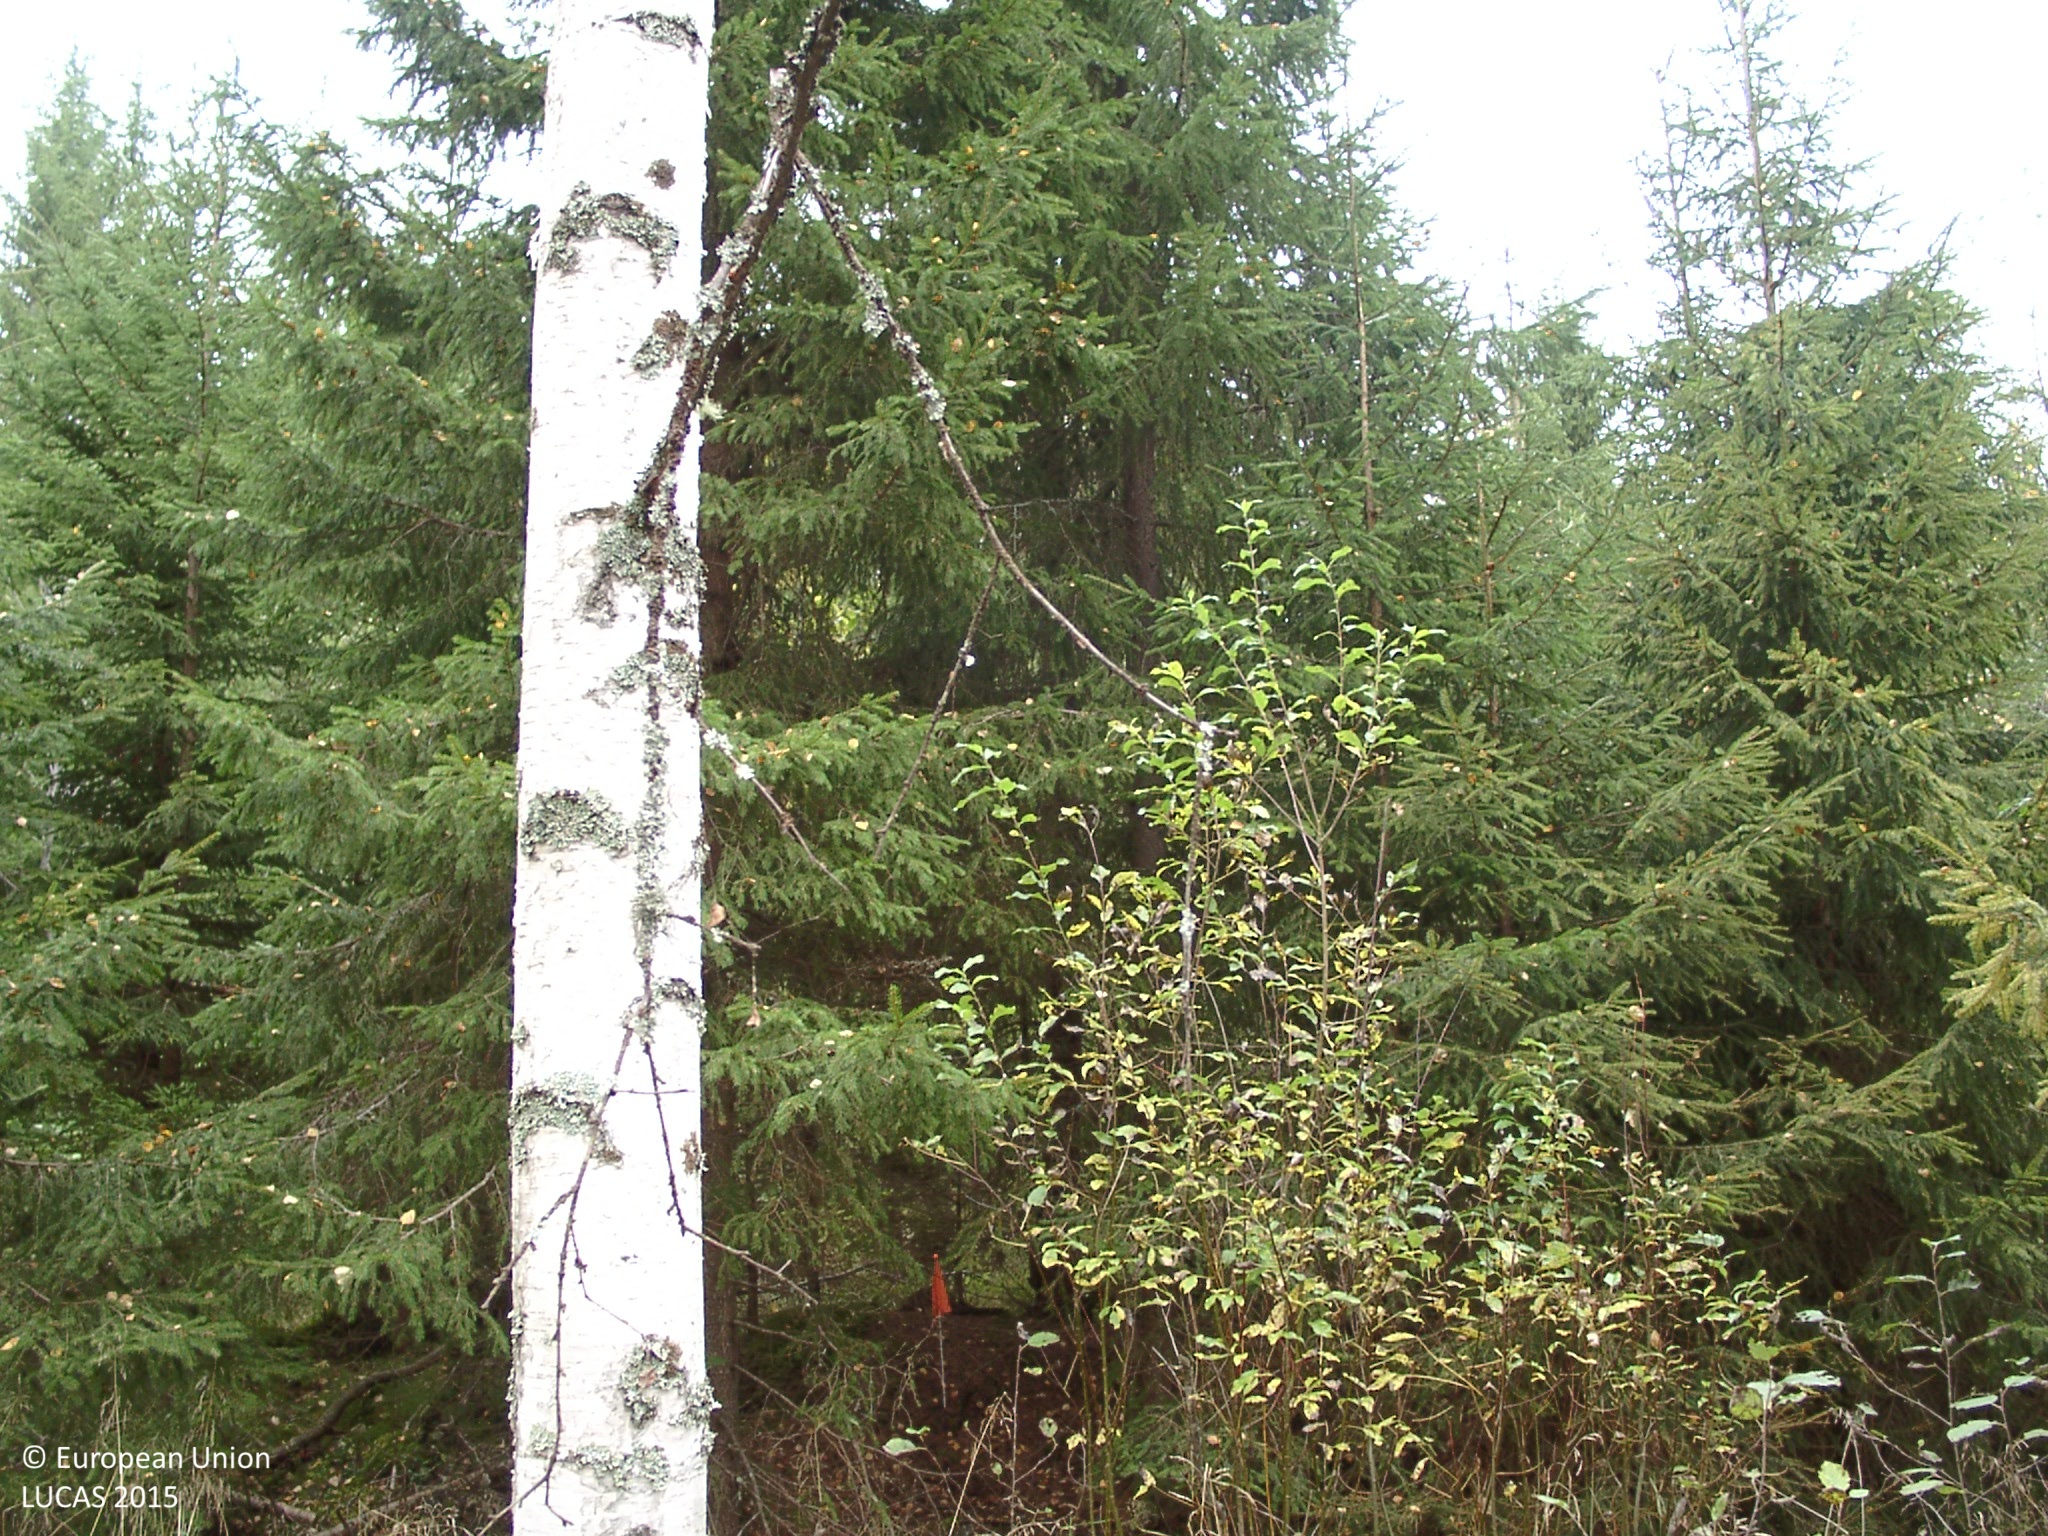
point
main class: Woodland
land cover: Spruce dominated coniferous woodland
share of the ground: > 75 %
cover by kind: coniferous forest trees 85 %, shrubs 5 %, herbaceous plants 5 %, lichens and mosses 5 %
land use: Forestry
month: September
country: FI
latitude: 62.6312
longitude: 25.3347
